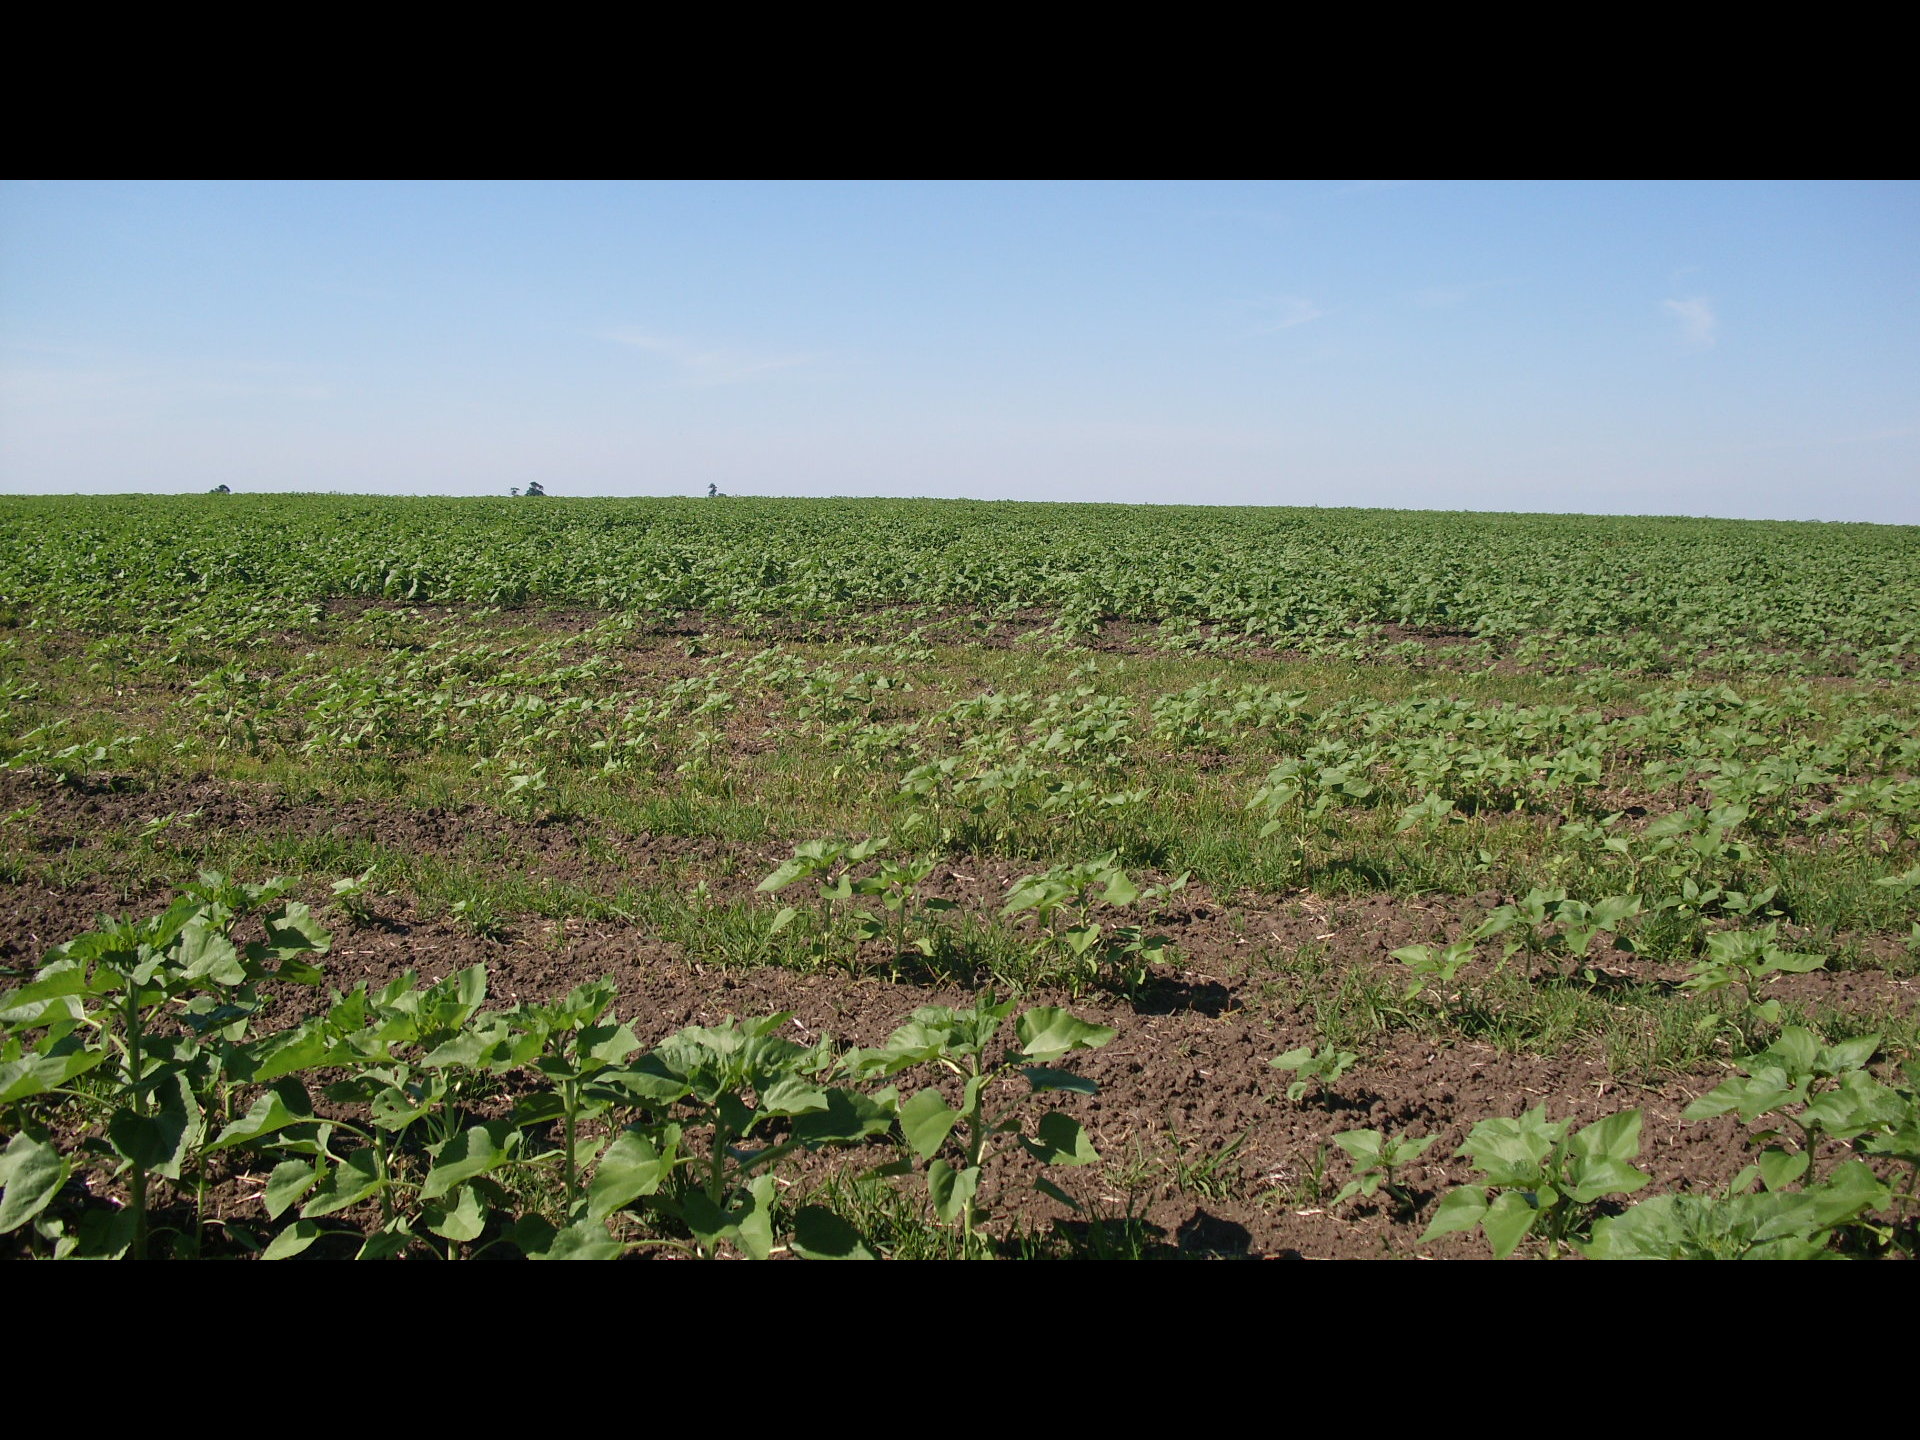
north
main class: Cropland
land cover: Sunflower
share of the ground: 50 - 75 %
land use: Agriculture (excluding fallow land and kitchen gardens)
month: June
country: BG
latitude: 43.5516
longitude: 23.2486
